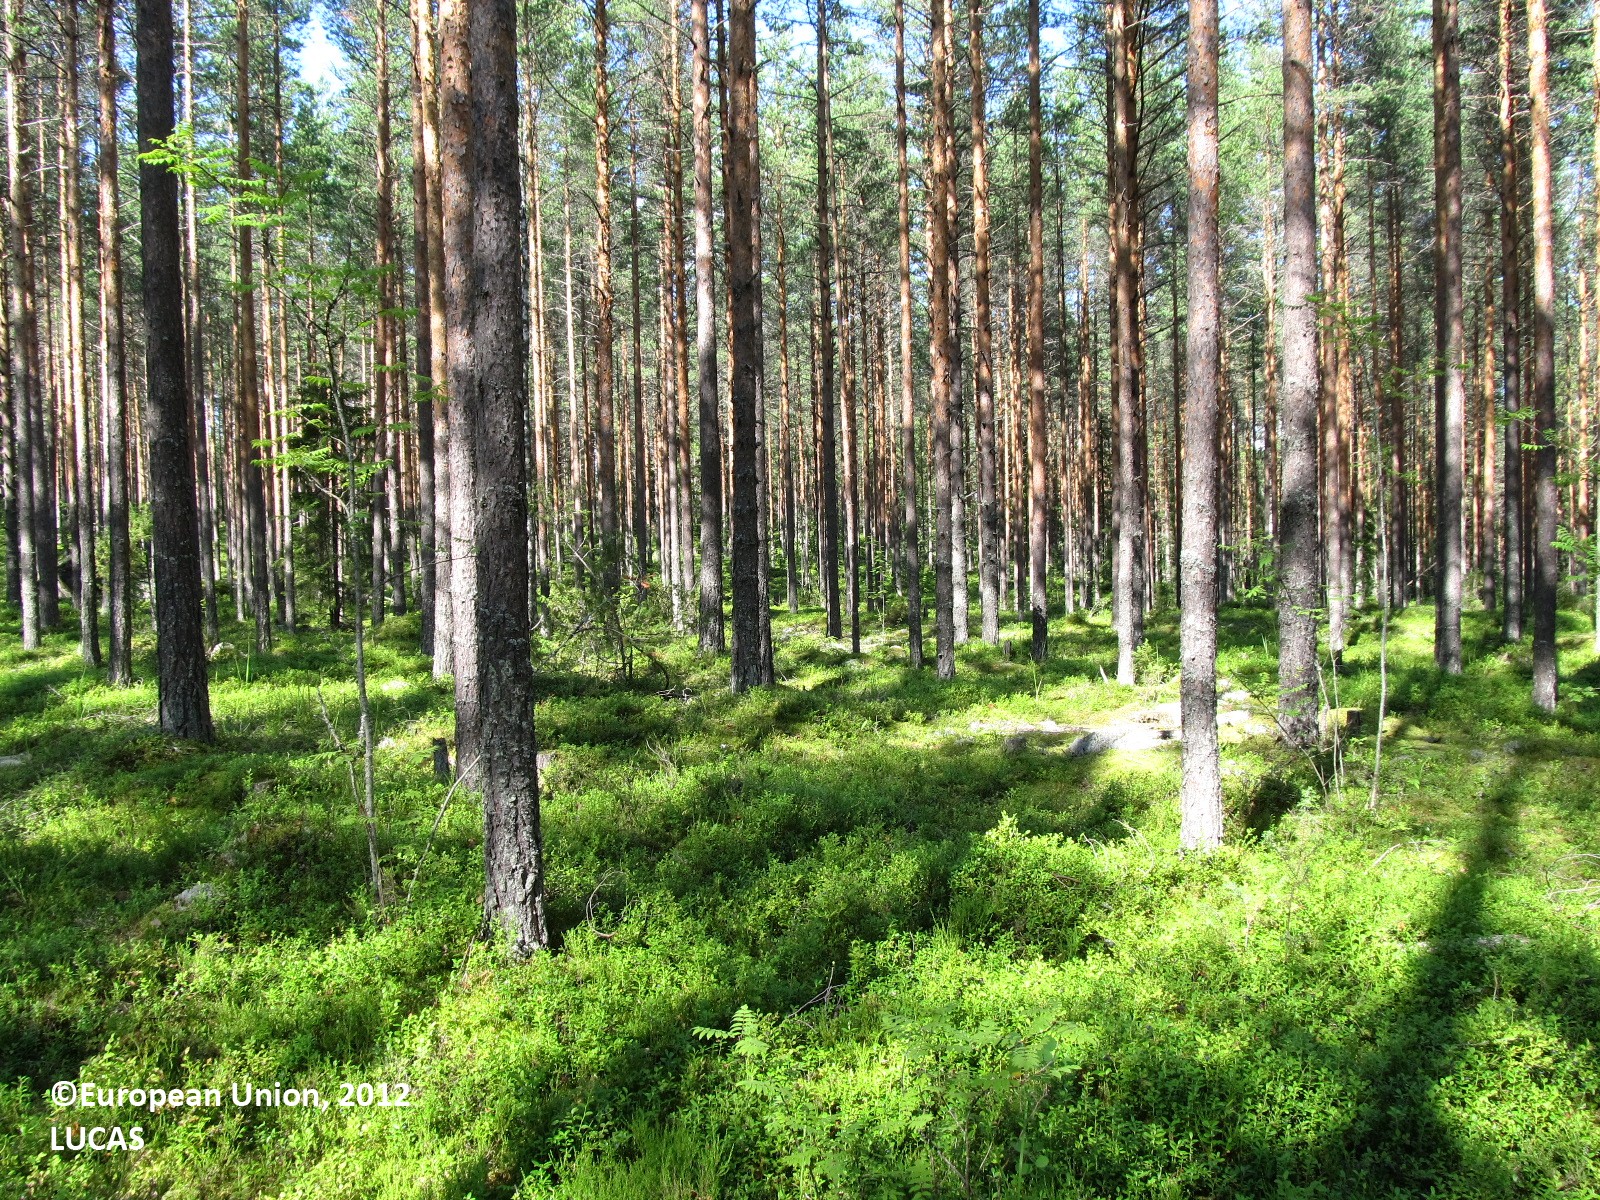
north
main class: Woodland
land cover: Pine dominated coniferous woodland
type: boreal forest
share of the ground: 50 - 75 %
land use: Forestry
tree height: > 5 m
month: July
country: FI
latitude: 61.8698
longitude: 27.9662
